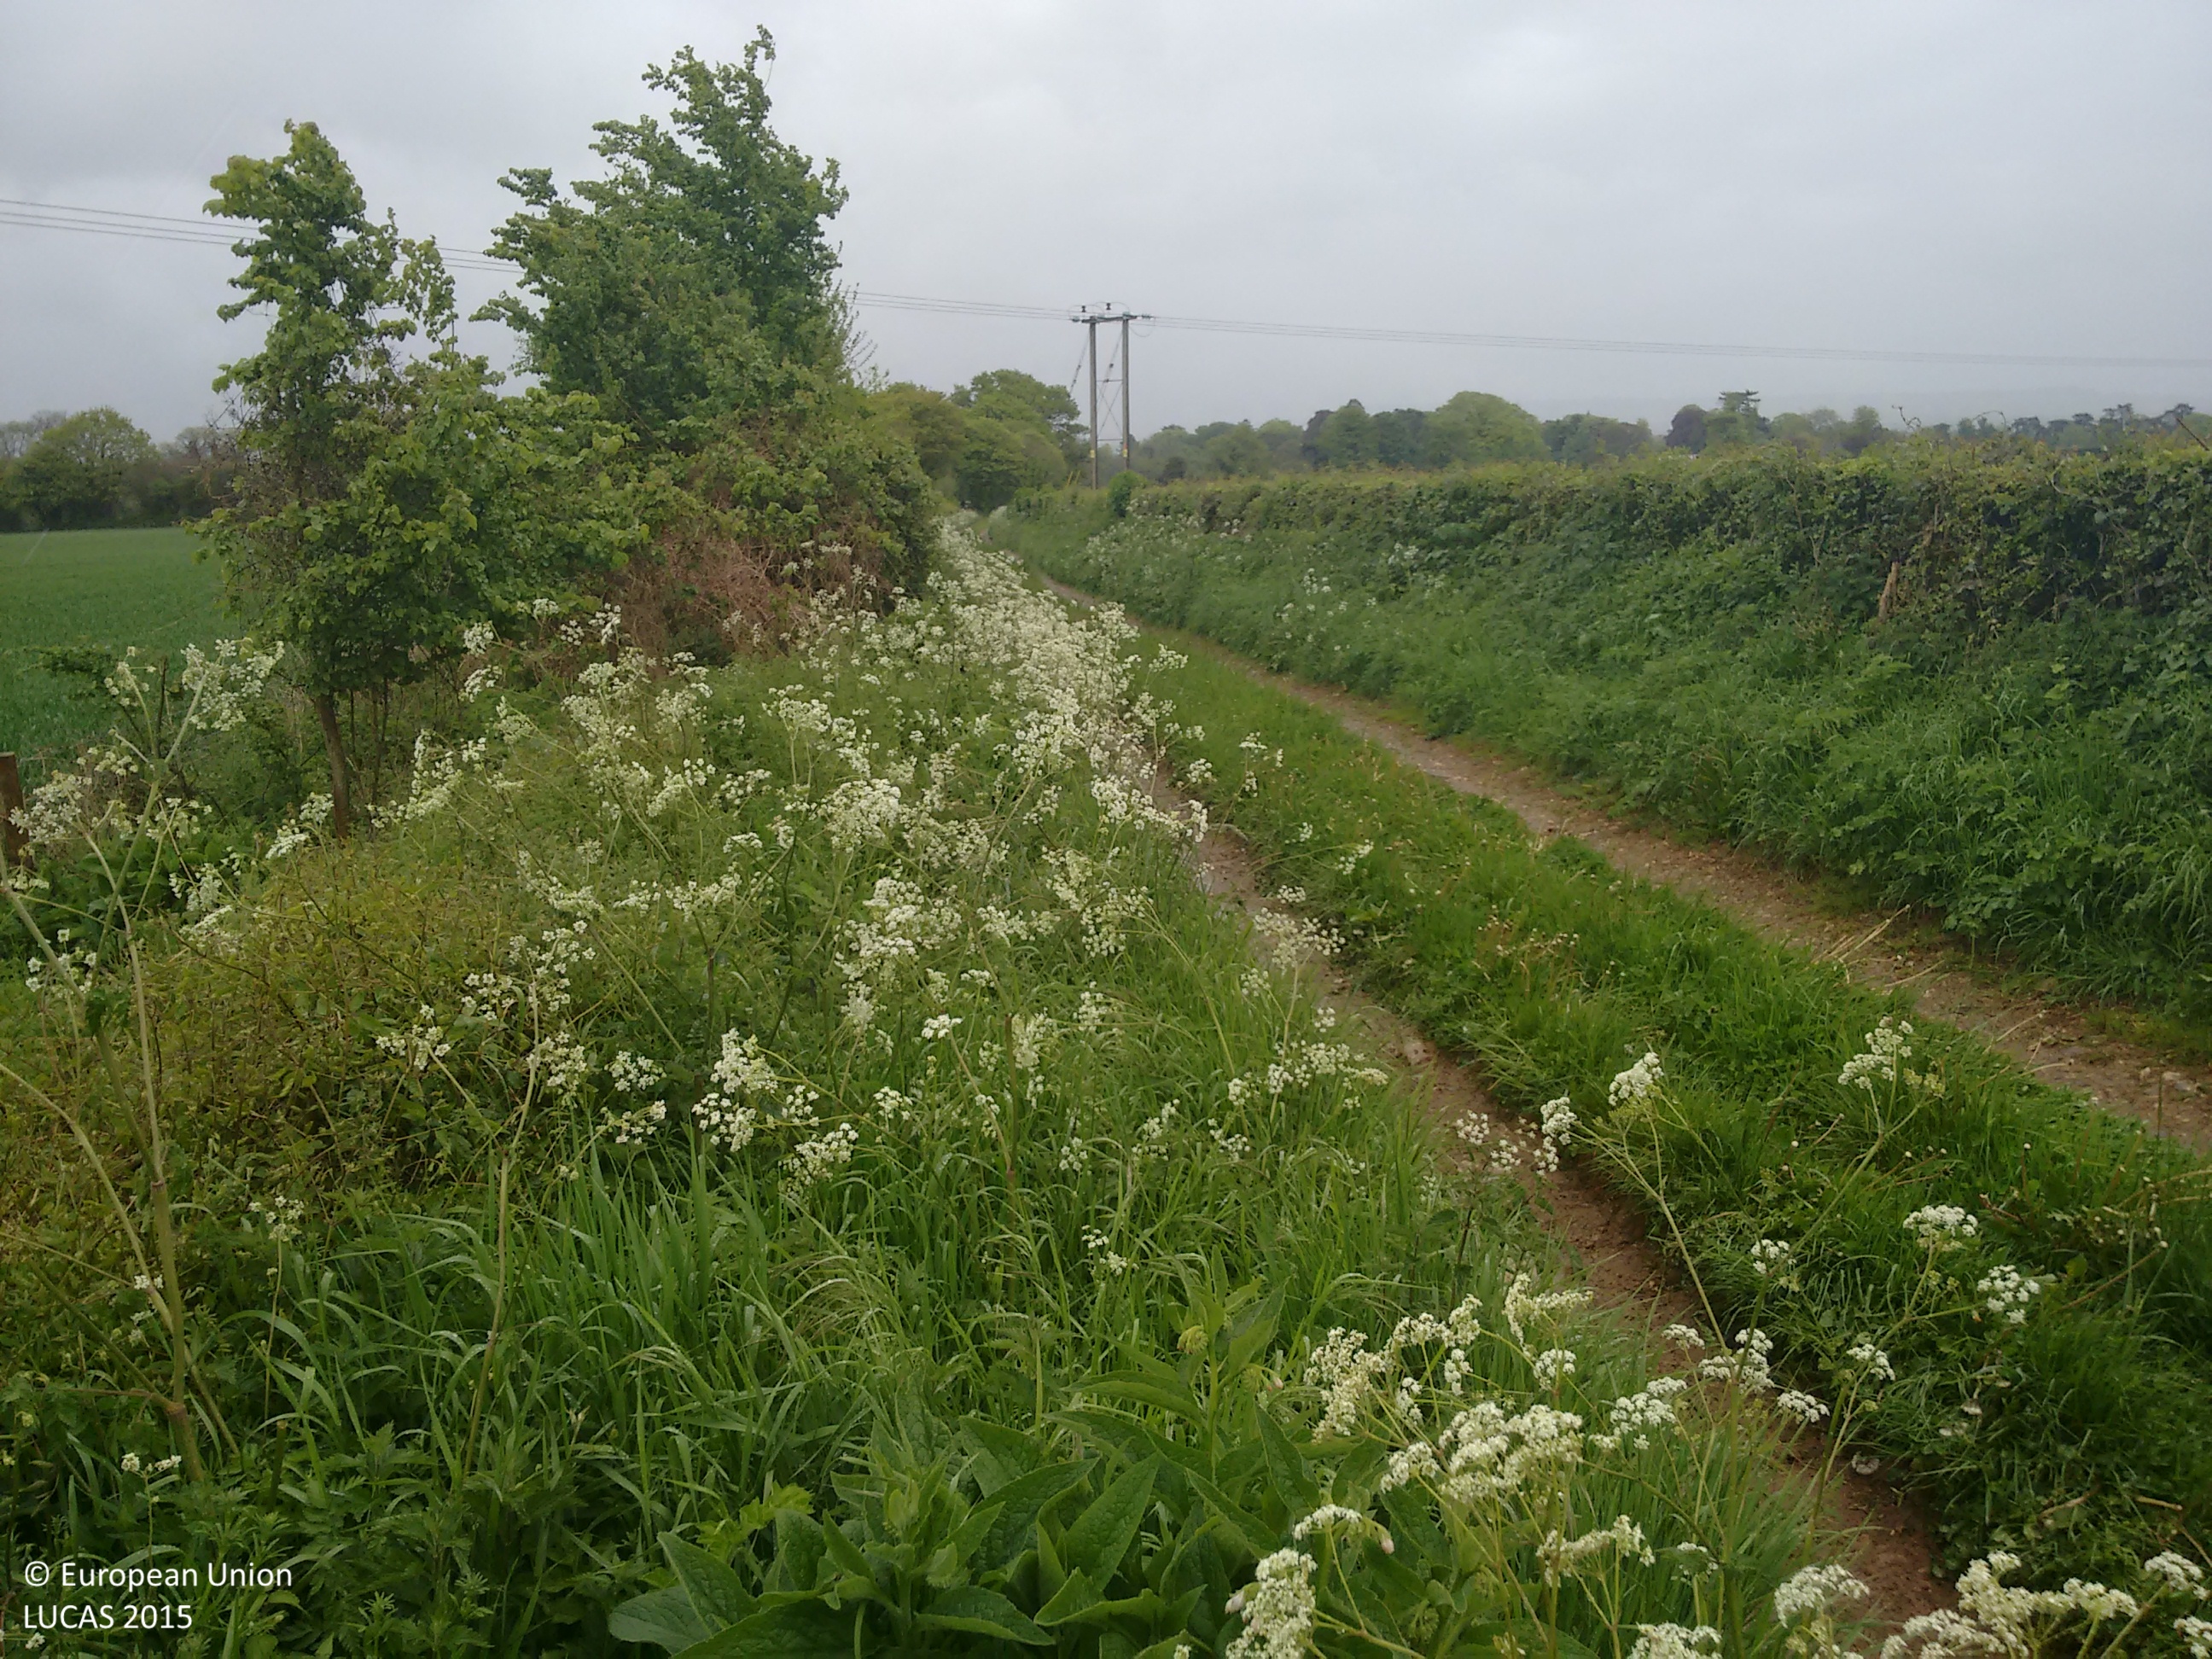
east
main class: Cropland
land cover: Common wheat
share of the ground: > 75 %
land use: Agriculture (excluding fallow land and kitchen gardens)
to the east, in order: Common wheat; Grass margins; Managed hedges; Fences; Managed hedges; Grassland without tree/shrub cover
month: May
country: GB
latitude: 51.0419
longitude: -2.3148
